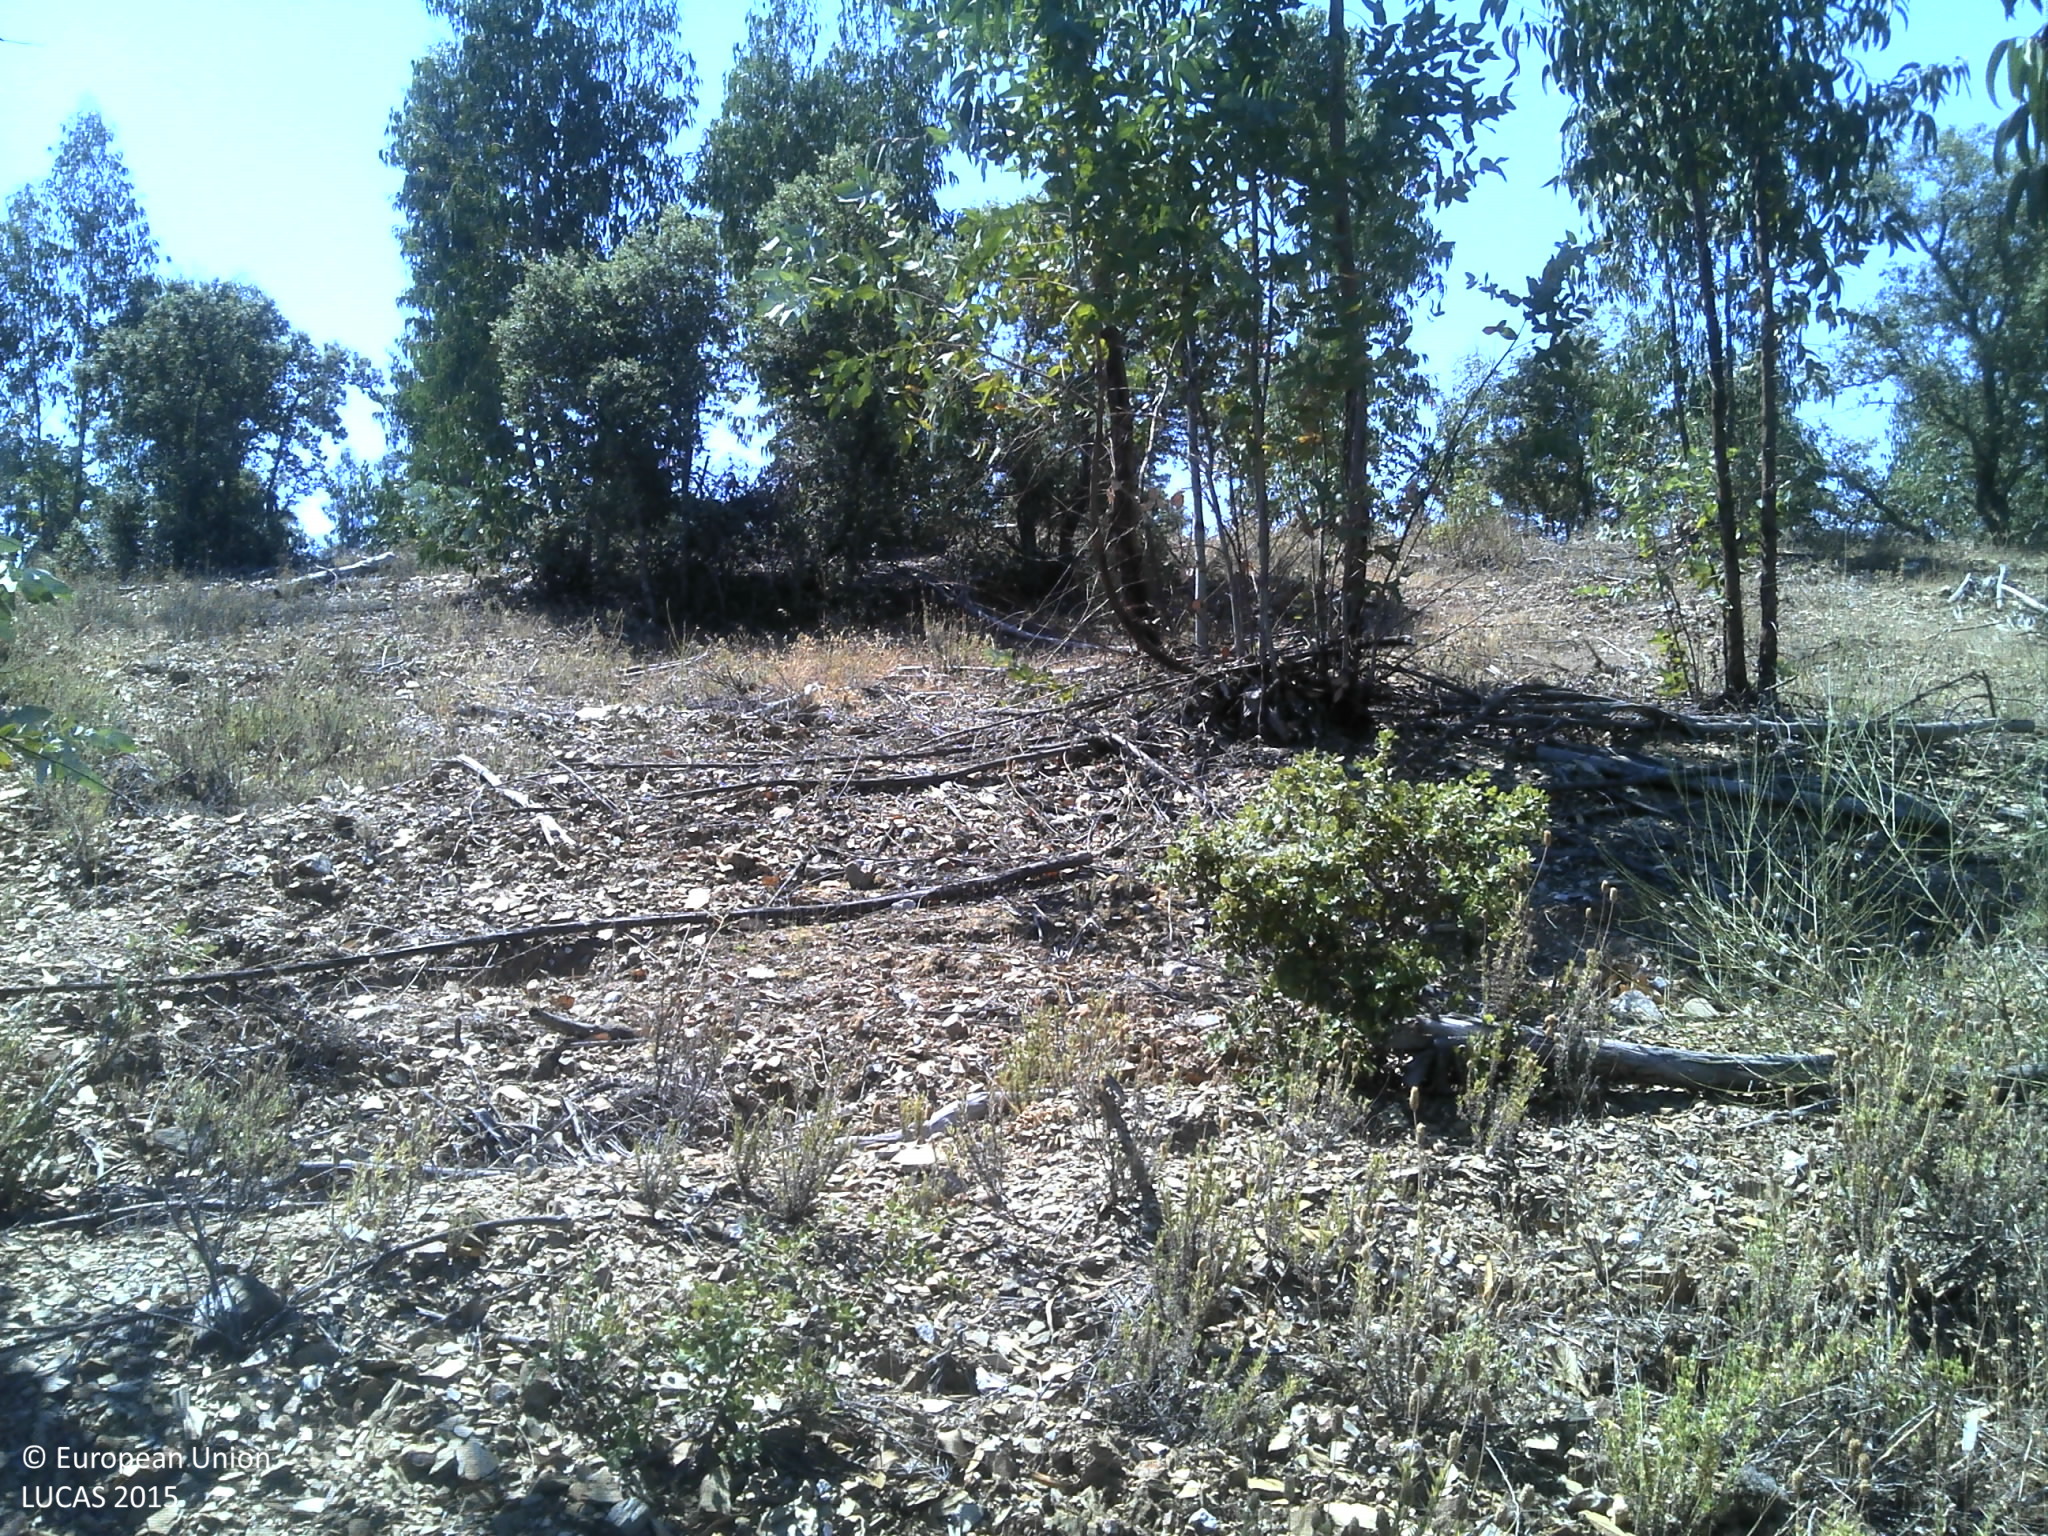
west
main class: Woodland
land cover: Broadleaved woodland
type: exotic forest
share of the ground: 25 - 50 %
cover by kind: broadleaved forest trees 50 %, unconsolidated bare surface 35 %, shrubs 15 %
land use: Forestry
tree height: > 5 m
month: June
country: PT
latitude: 39.7453
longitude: -7.0197
